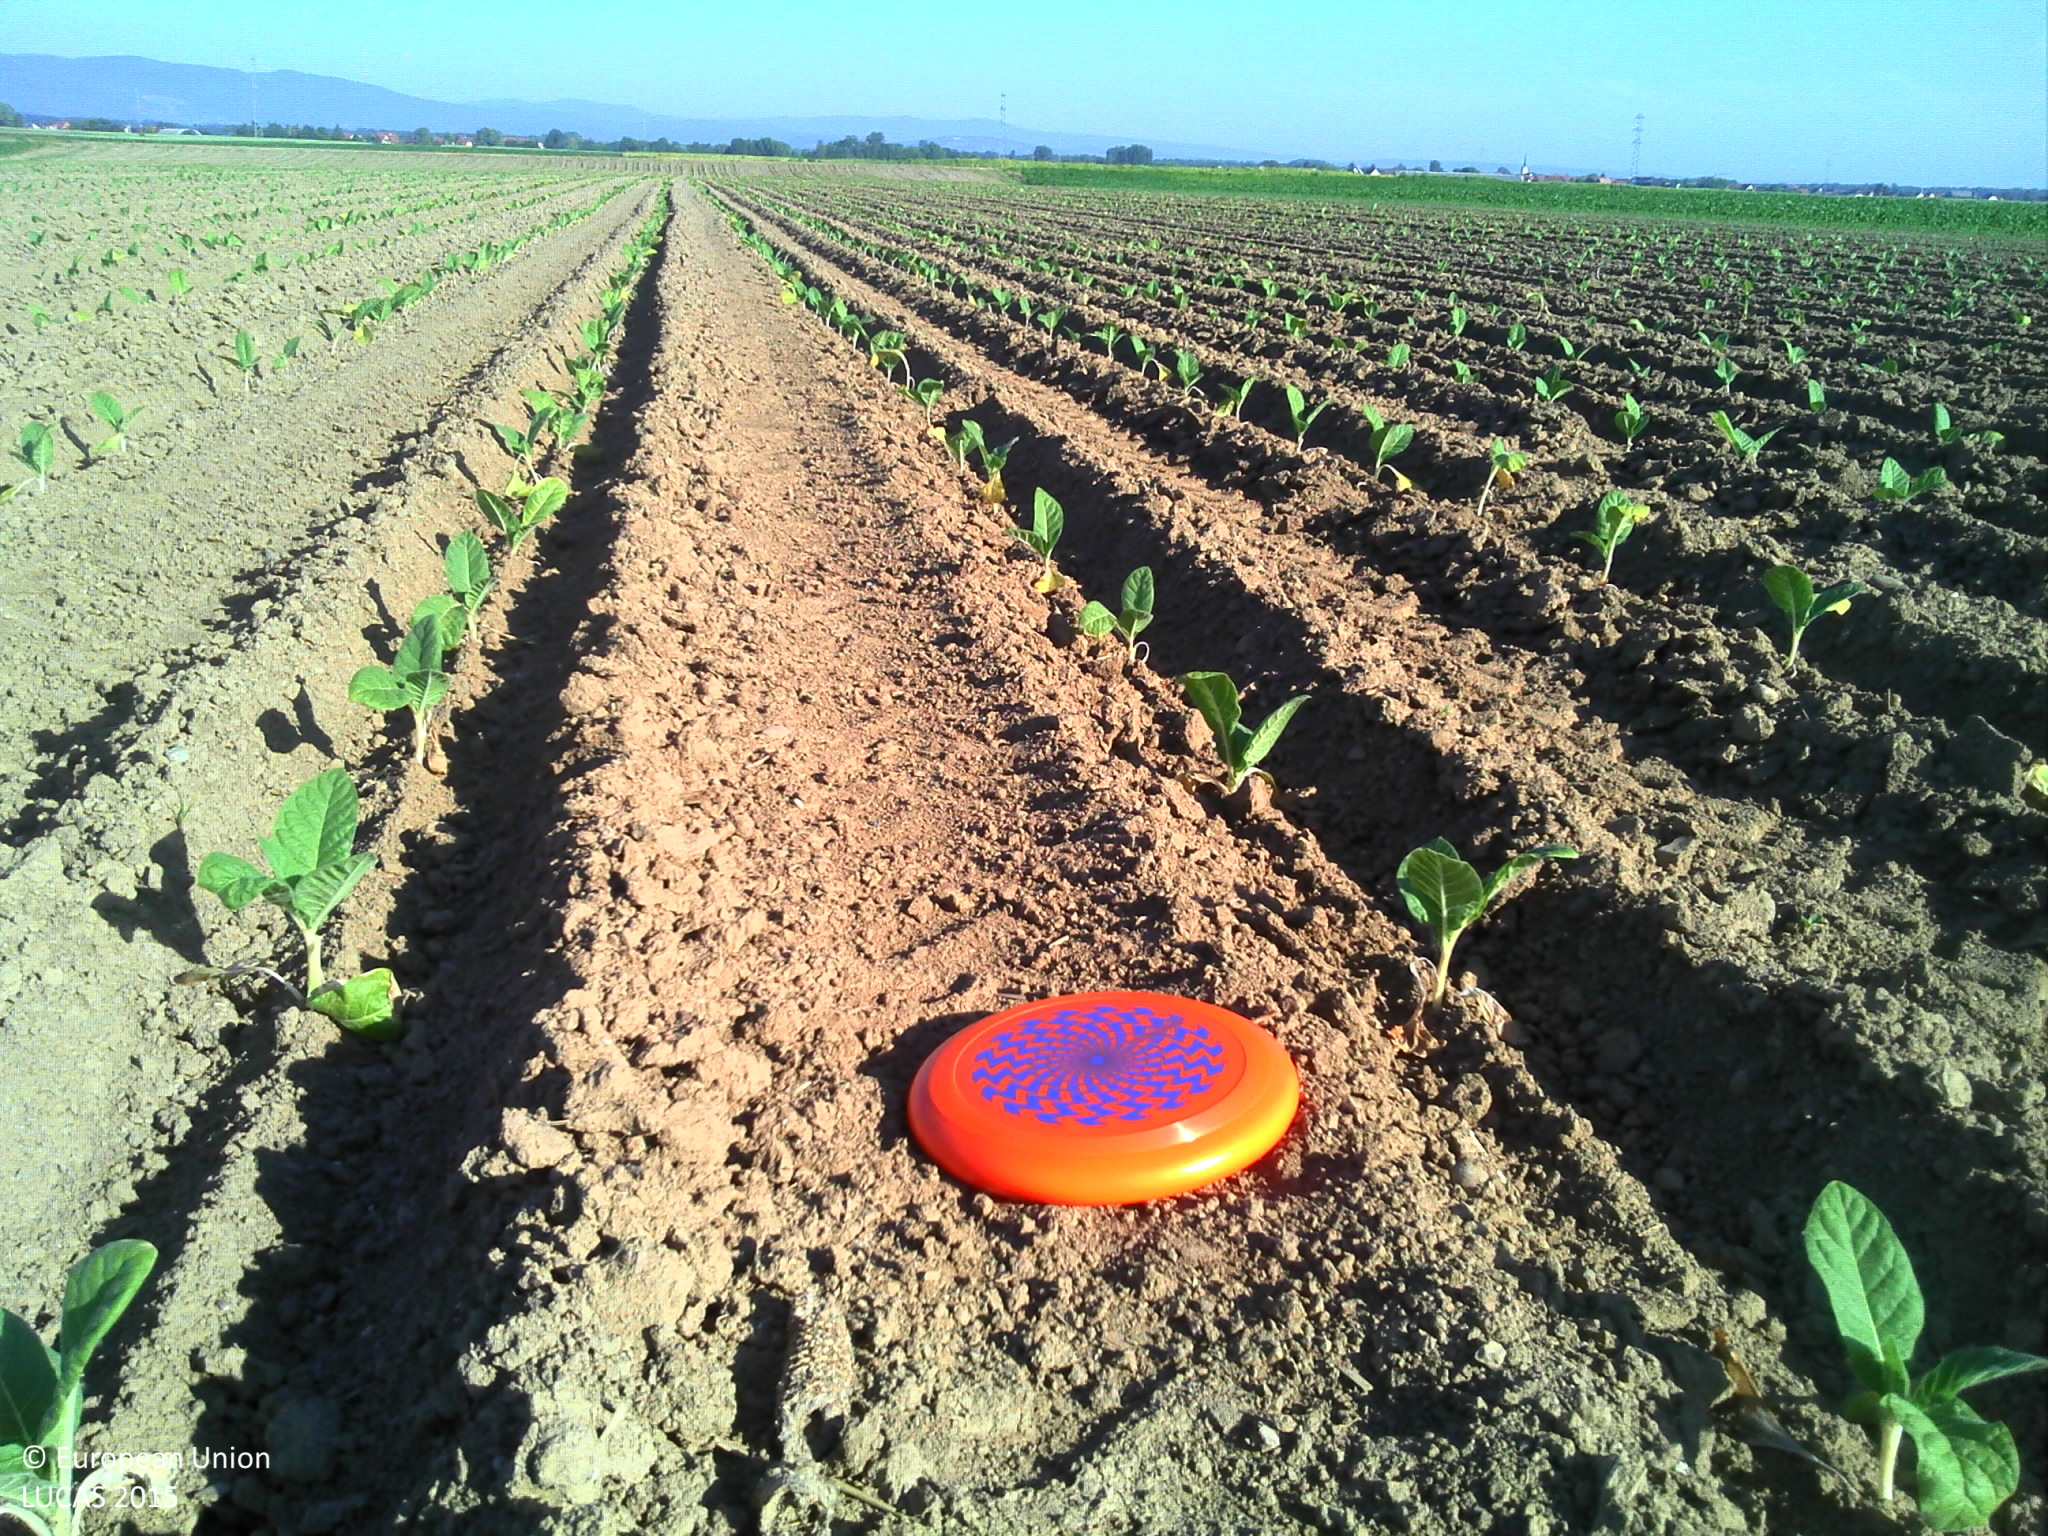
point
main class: Cropland
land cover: Tobacco
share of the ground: 10 - 25 %
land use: Agriculture (excluding fallow land and kitchen gardens)
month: June
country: FR
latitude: 48.3957
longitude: 7.6104
